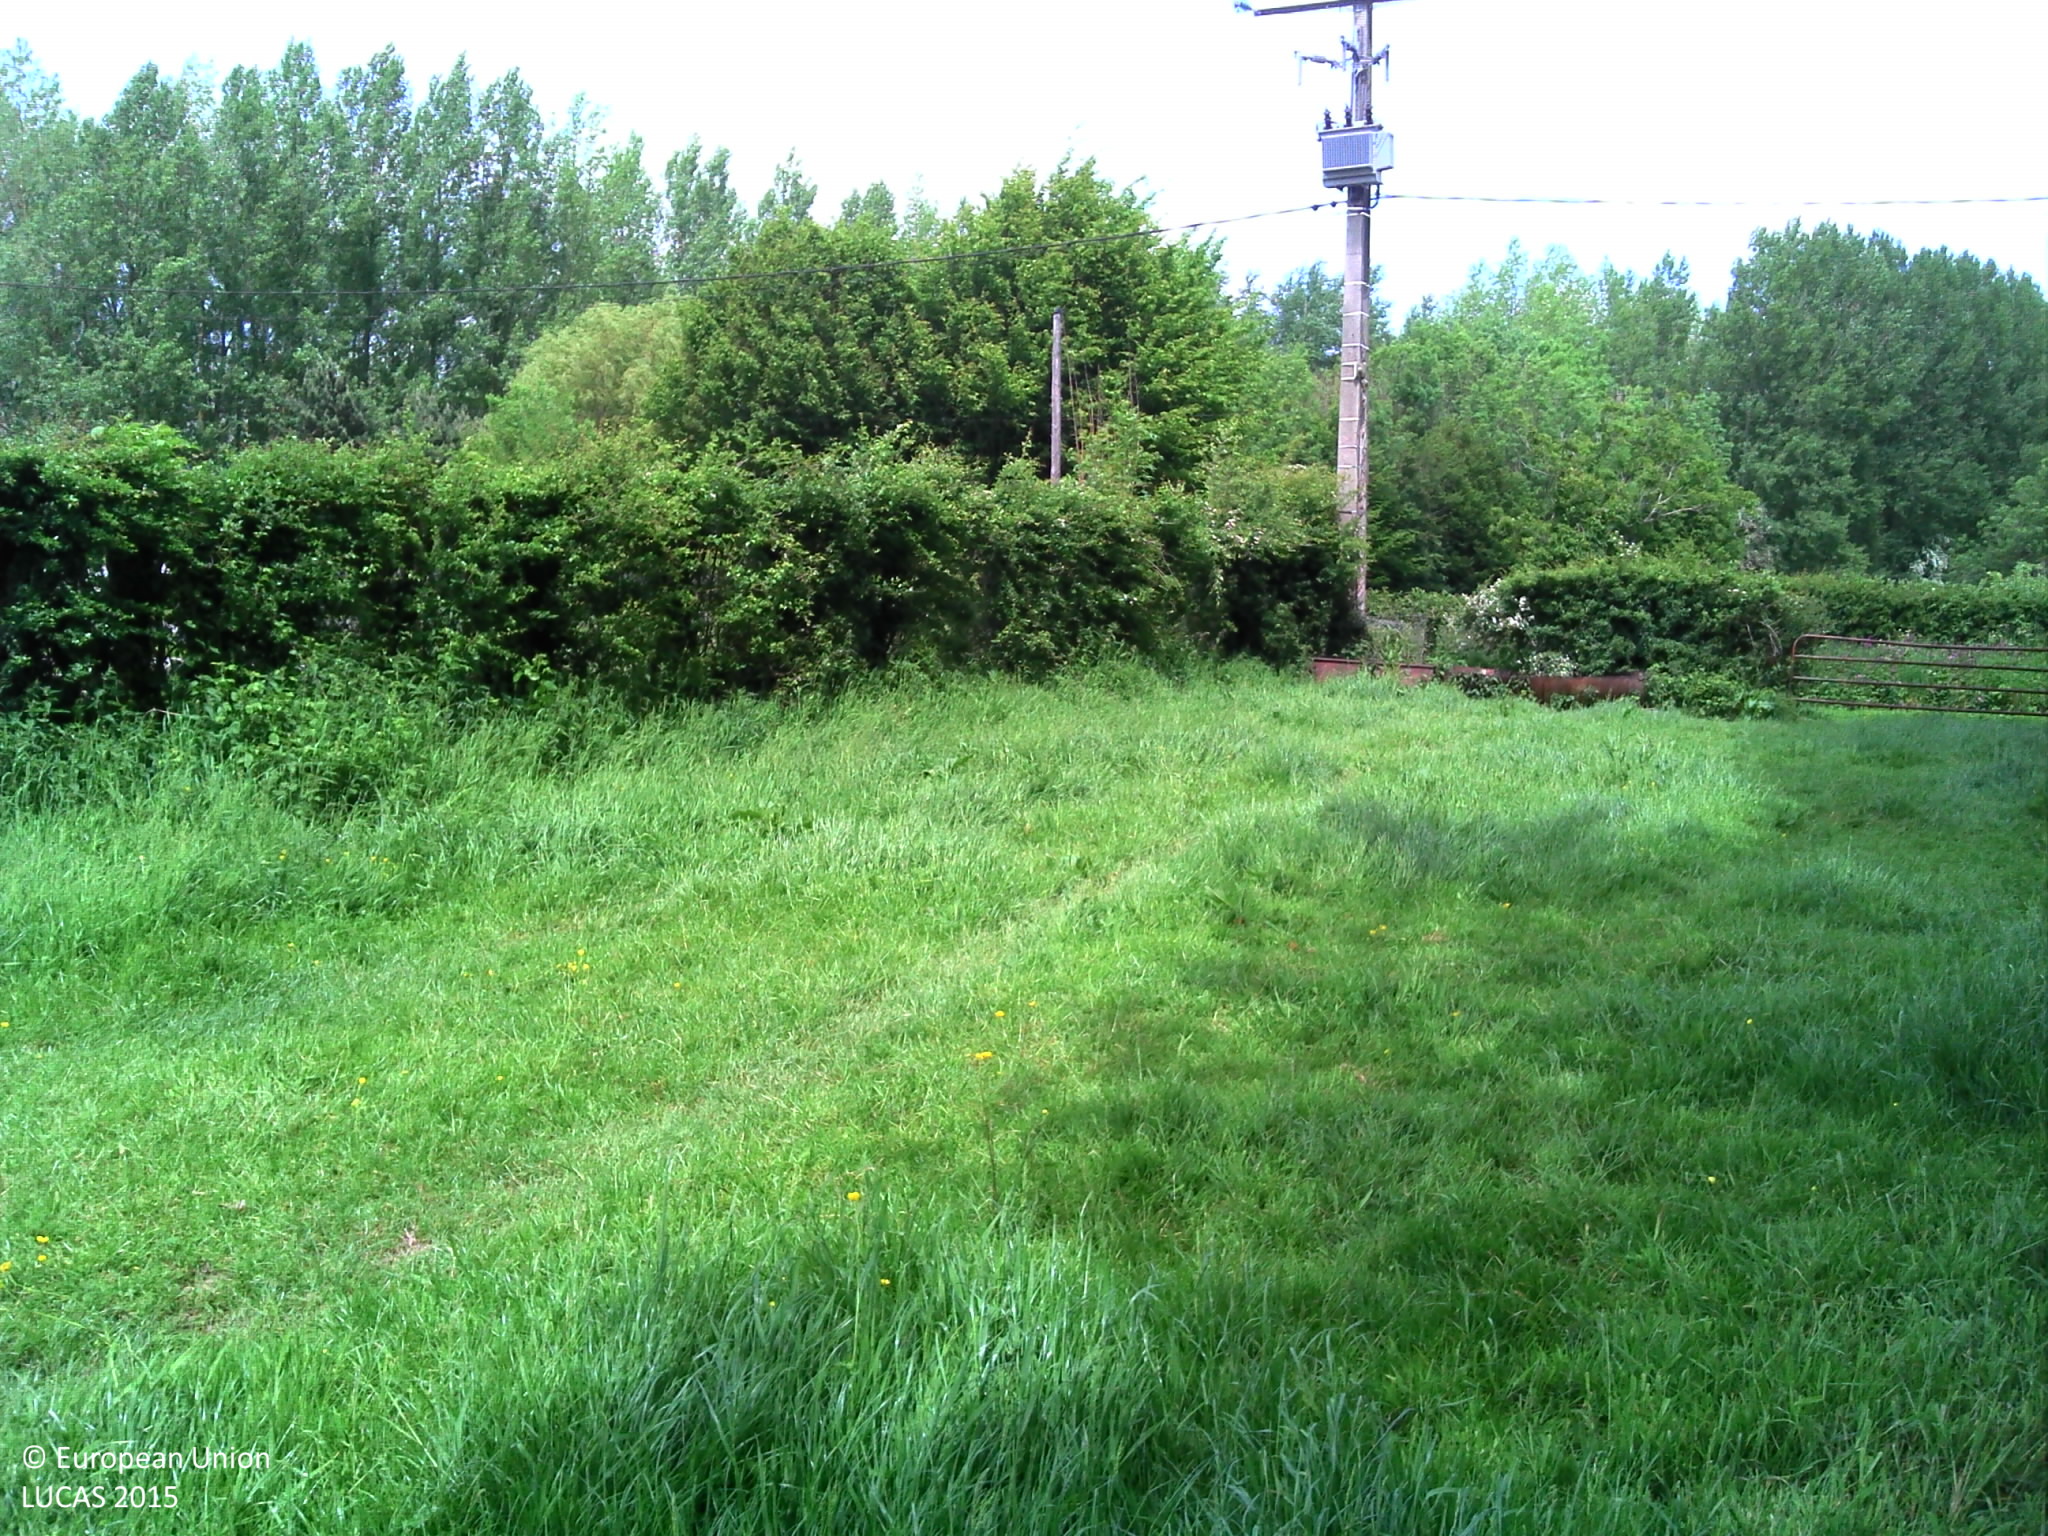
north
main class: Woodland
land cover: Broadleaved woodland
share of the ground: 50 - 75 %
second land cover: Grassland without tree/shrub cover
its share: 25 - 50 %
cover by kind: broadleaved forest trees 70 %, herbaceous plants 30 %
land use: Forestry
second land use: Agriculture (excluding fallow land and kitchen gardens)
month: May
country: FR
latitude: 50.5816
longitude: 2.1471
